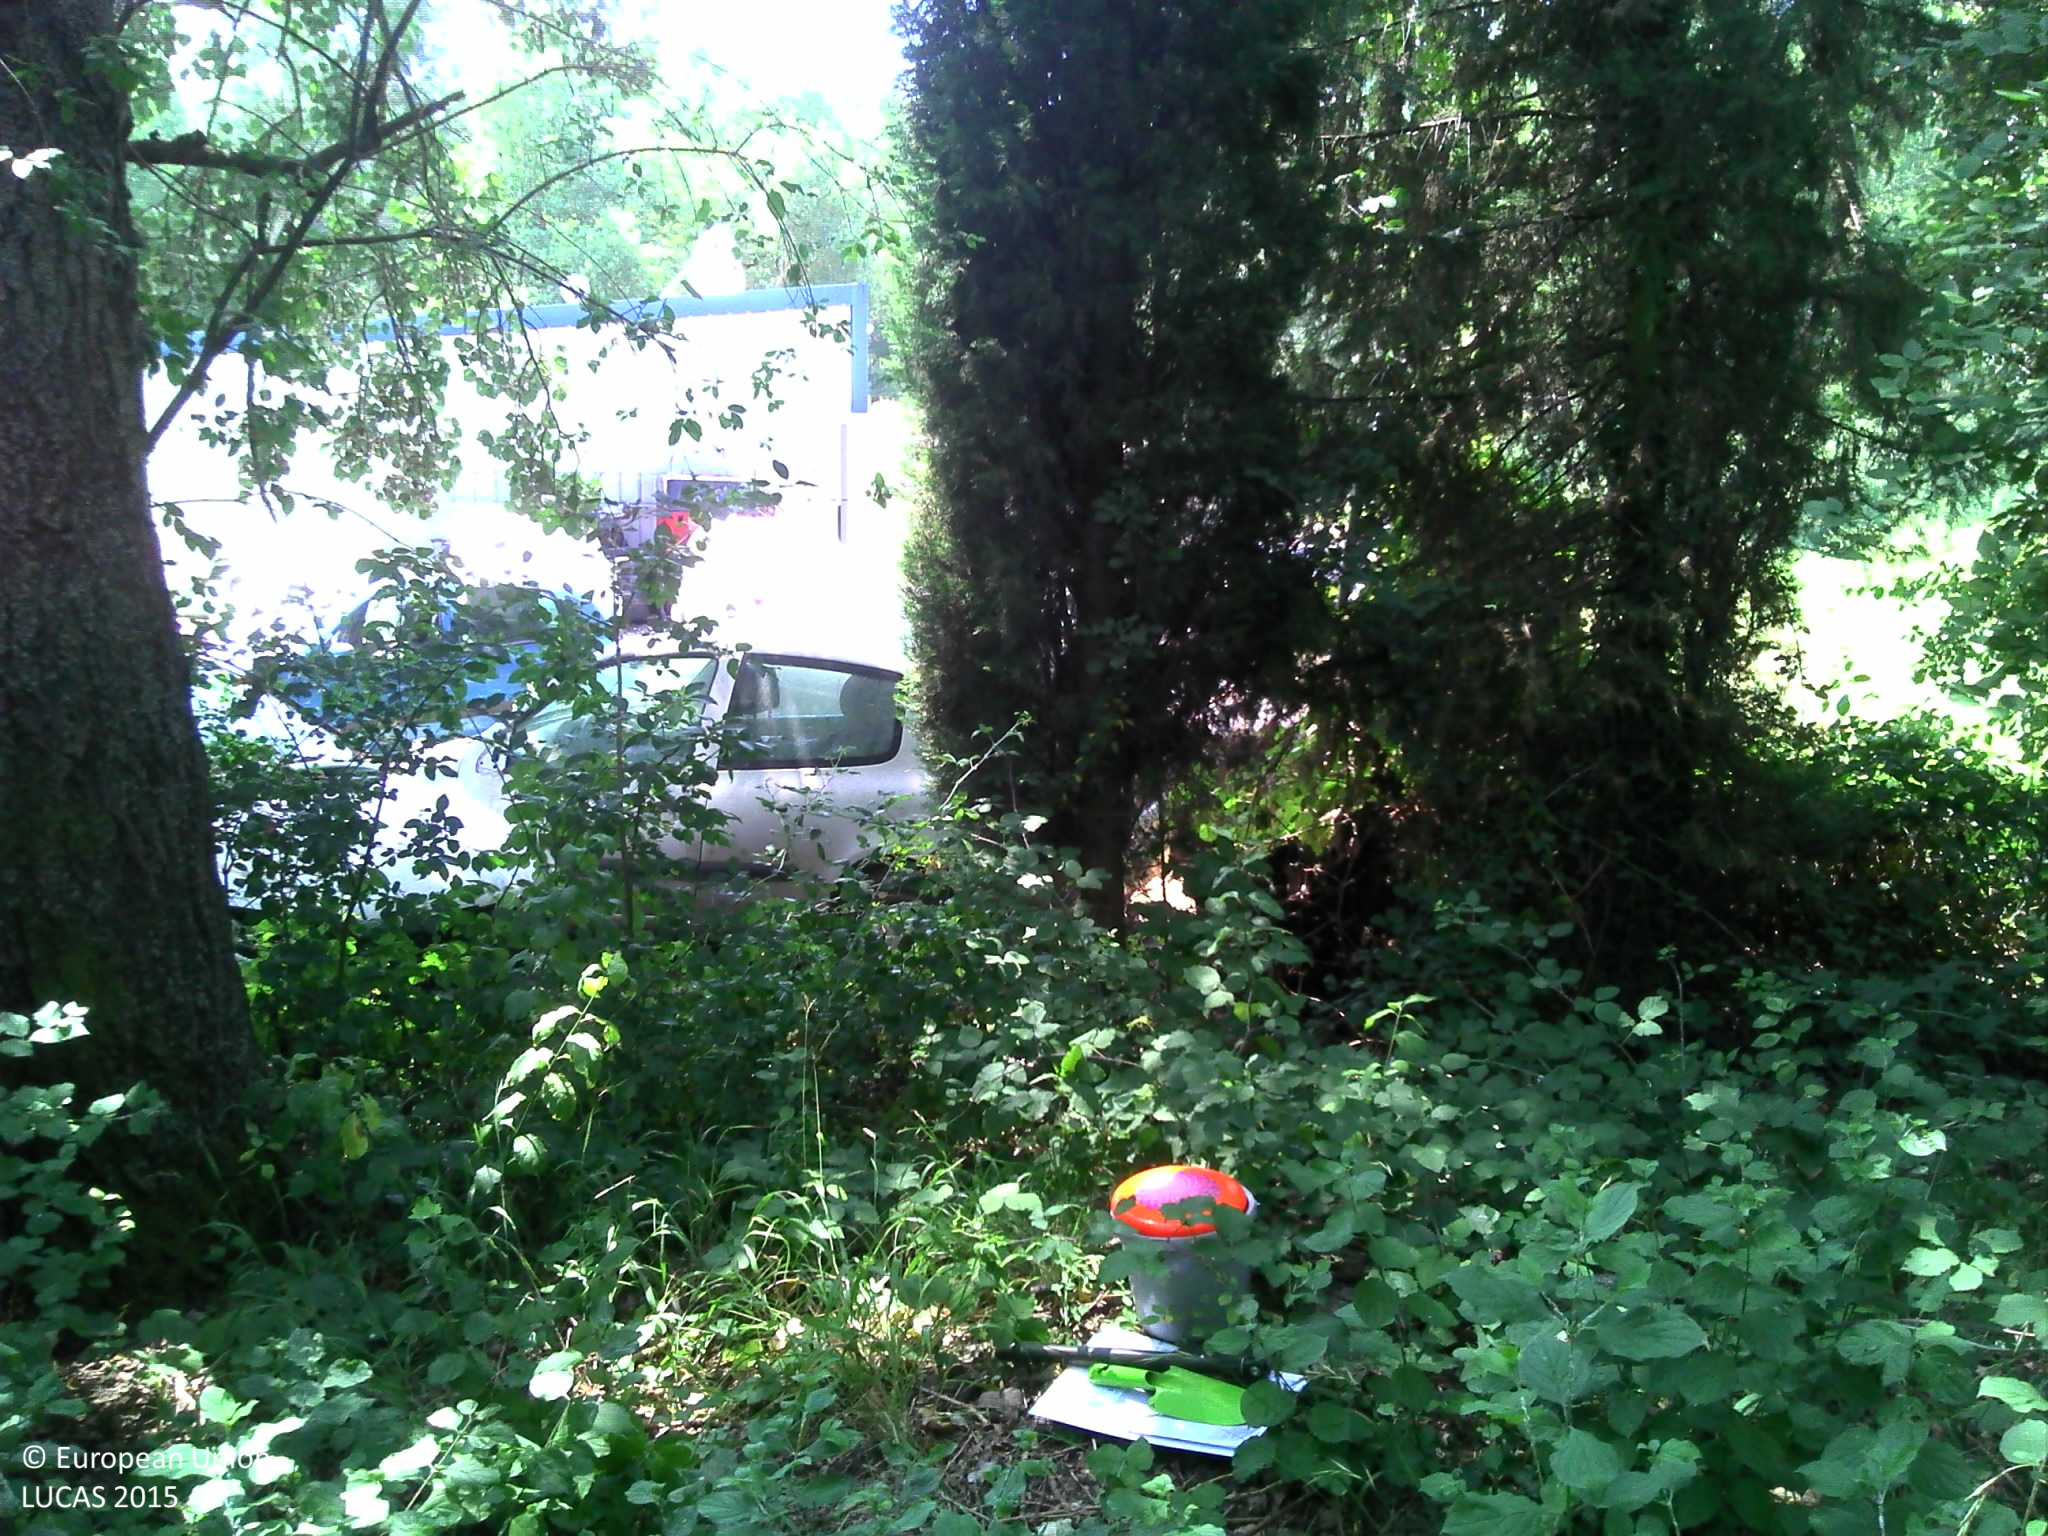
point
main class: Woodland
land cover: Broadleaved woodland
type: floodplain forest
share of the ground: 50 - 75 %
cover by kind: broadleaved forest trees 60 %, shrubs 20 %, coniferous forest trees 10 %, herbaceous plants 10 %
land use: Semi-natural and natural areas not in use
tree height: > 5 m
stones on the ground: < 10 %
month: July
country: FR
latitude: 44.2518
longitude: 4.7100
